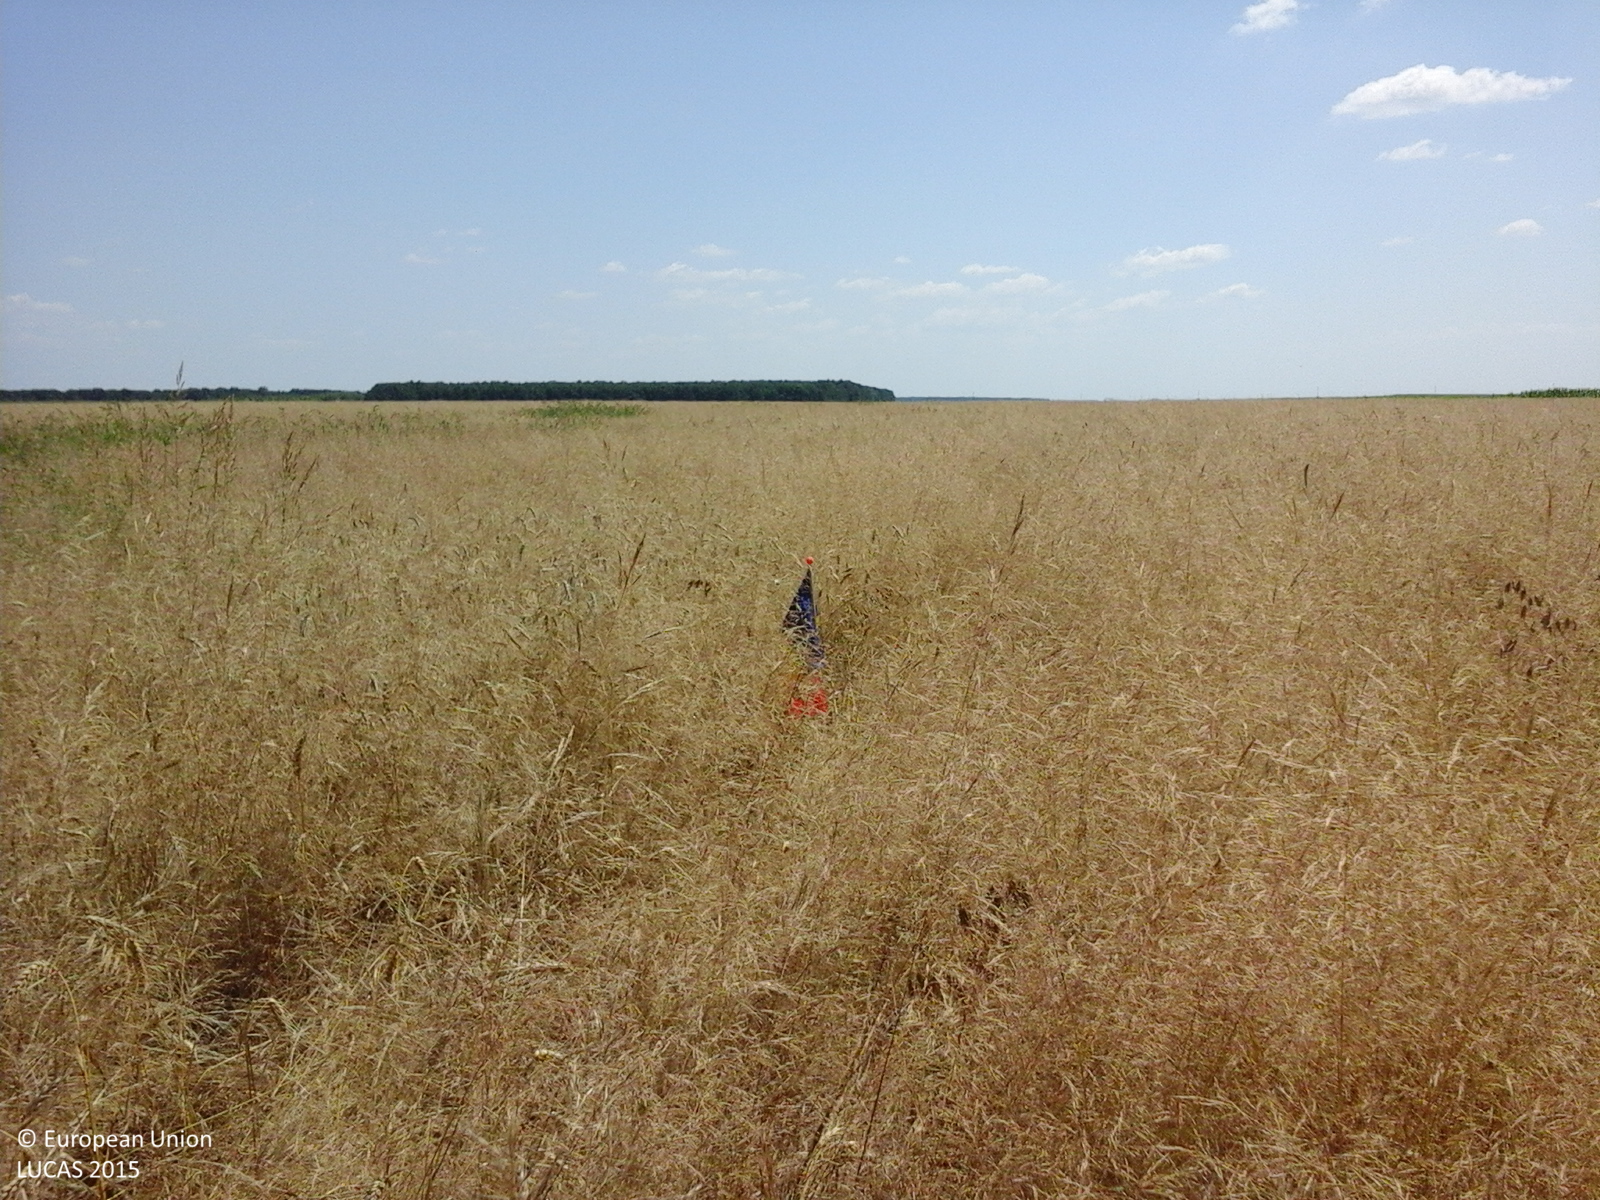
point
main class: Cropland
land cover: Common wheat
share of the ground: > 75 %
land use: Agriculture (excluding fallow land and kitchen gardens)
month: July
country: RO
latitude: 44.4799
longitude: 24.4916
